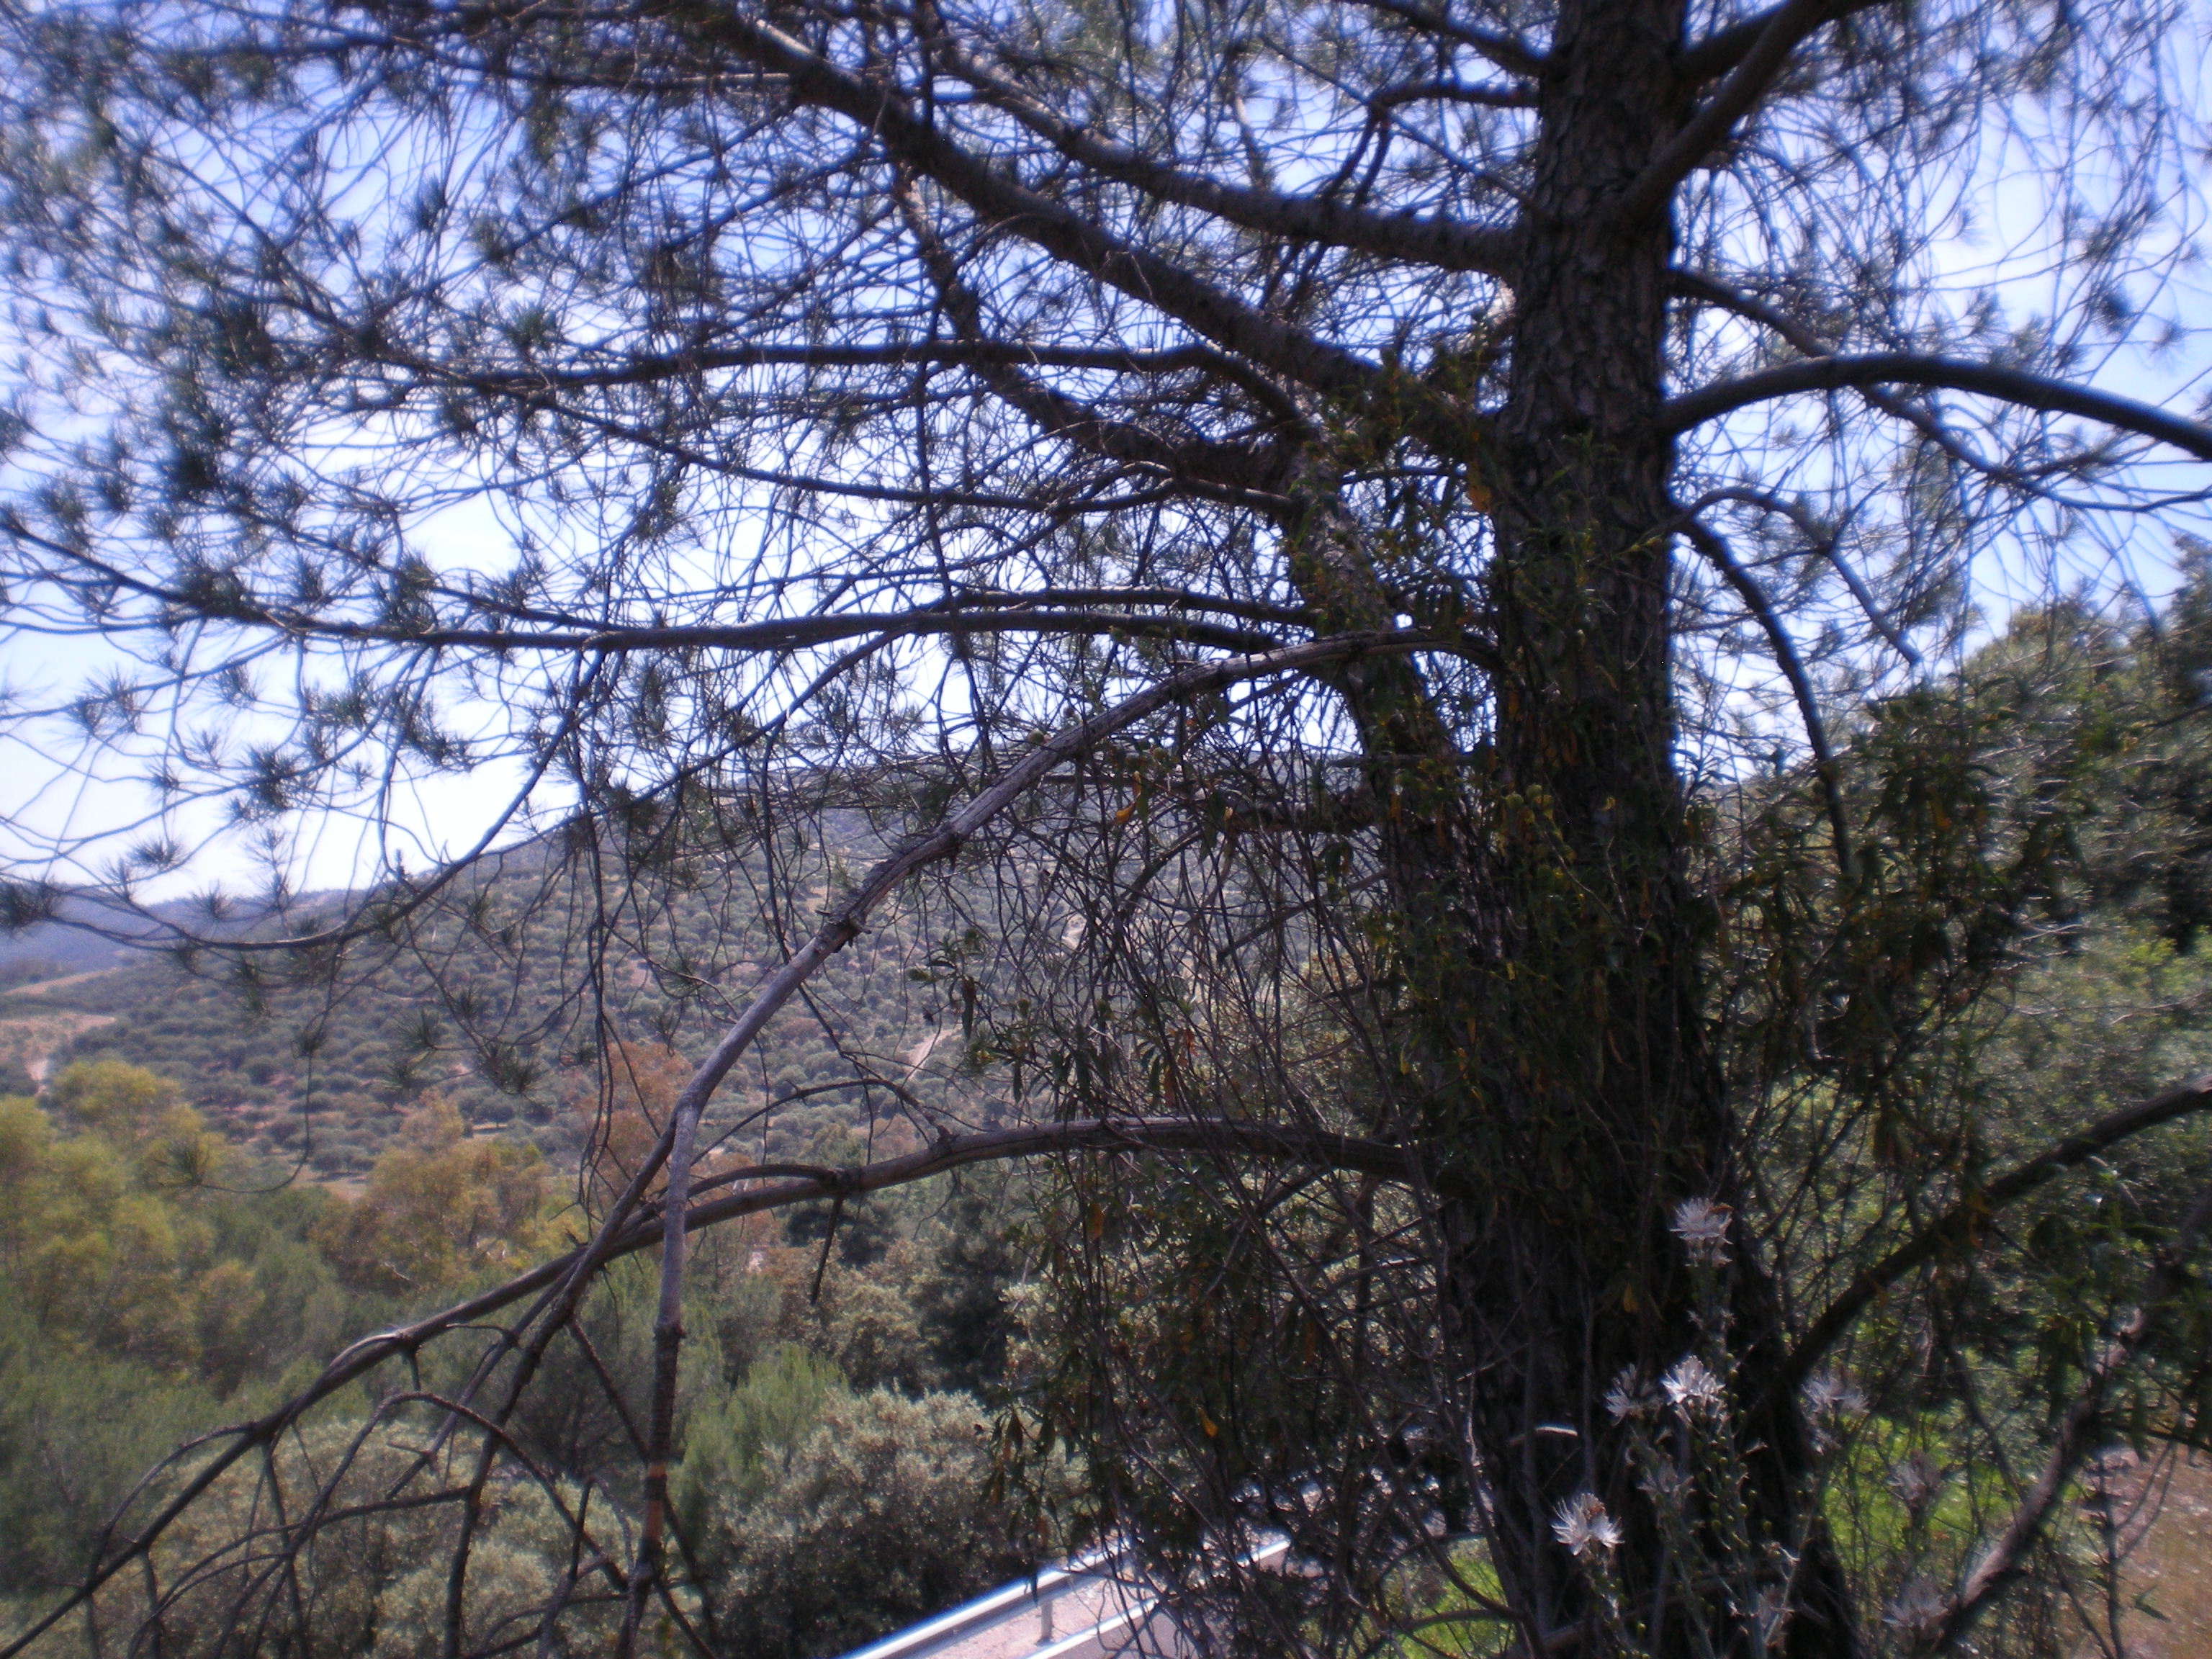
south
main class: Woodland
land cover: Pine dominated coniferous woodland
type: coniferous forest of the mediterranean region
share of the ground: 50 - 75 %
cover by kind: coniferous forest trees 30 %, shrubs 30 %, unconsolidated bare surface 25 %, herbaceous plants 10 %, broadleaved forest trees 5 %
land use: Semi-natural and natural areas not in use
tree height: > 5 m
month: May
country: ES
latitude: 38.3761
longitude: -3.5024
